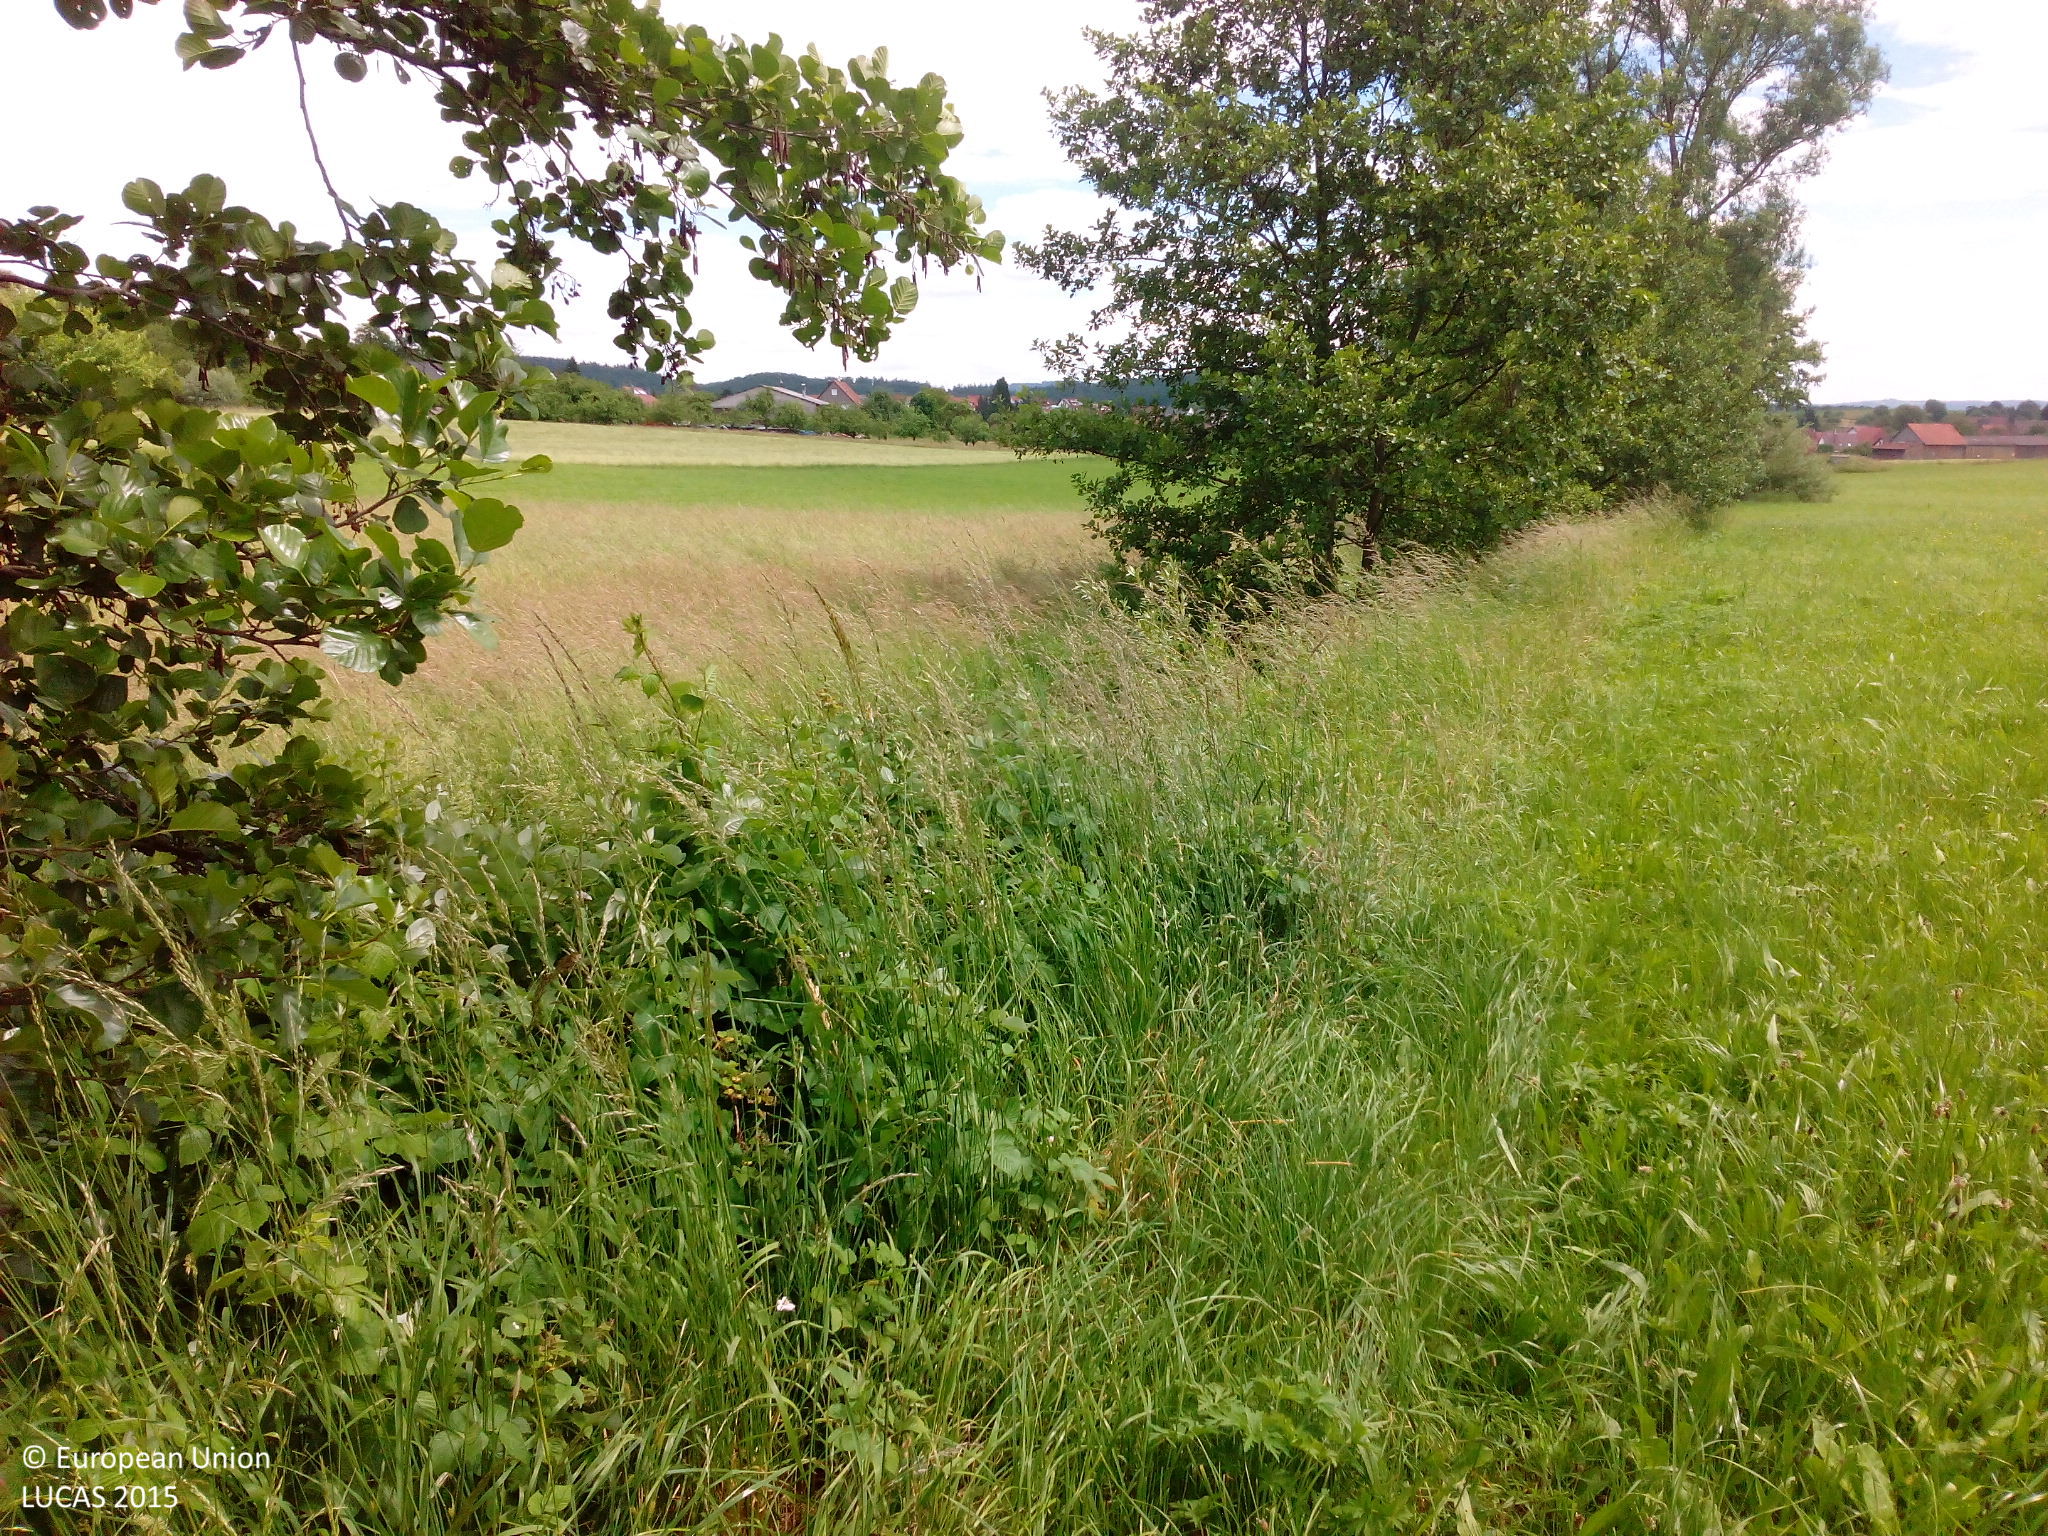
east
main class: Grassland
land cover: Grassland without tree/shrub cover
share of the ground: > 75 %
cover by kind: herbaceous plants 100 %
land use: Agriculture (excluding fallow land and kitchen gardens)
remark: Harvested field
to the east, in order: Grassland without tree/shrub cover; Broadleaved woodland; Ditches and canals; Grassland without tree/shrub cover; Common wheat; Apple fruit; Grass margins; Paved roads, cycling and walking lanes
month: June
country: DE
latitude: 48.9955
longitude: 9.3852
